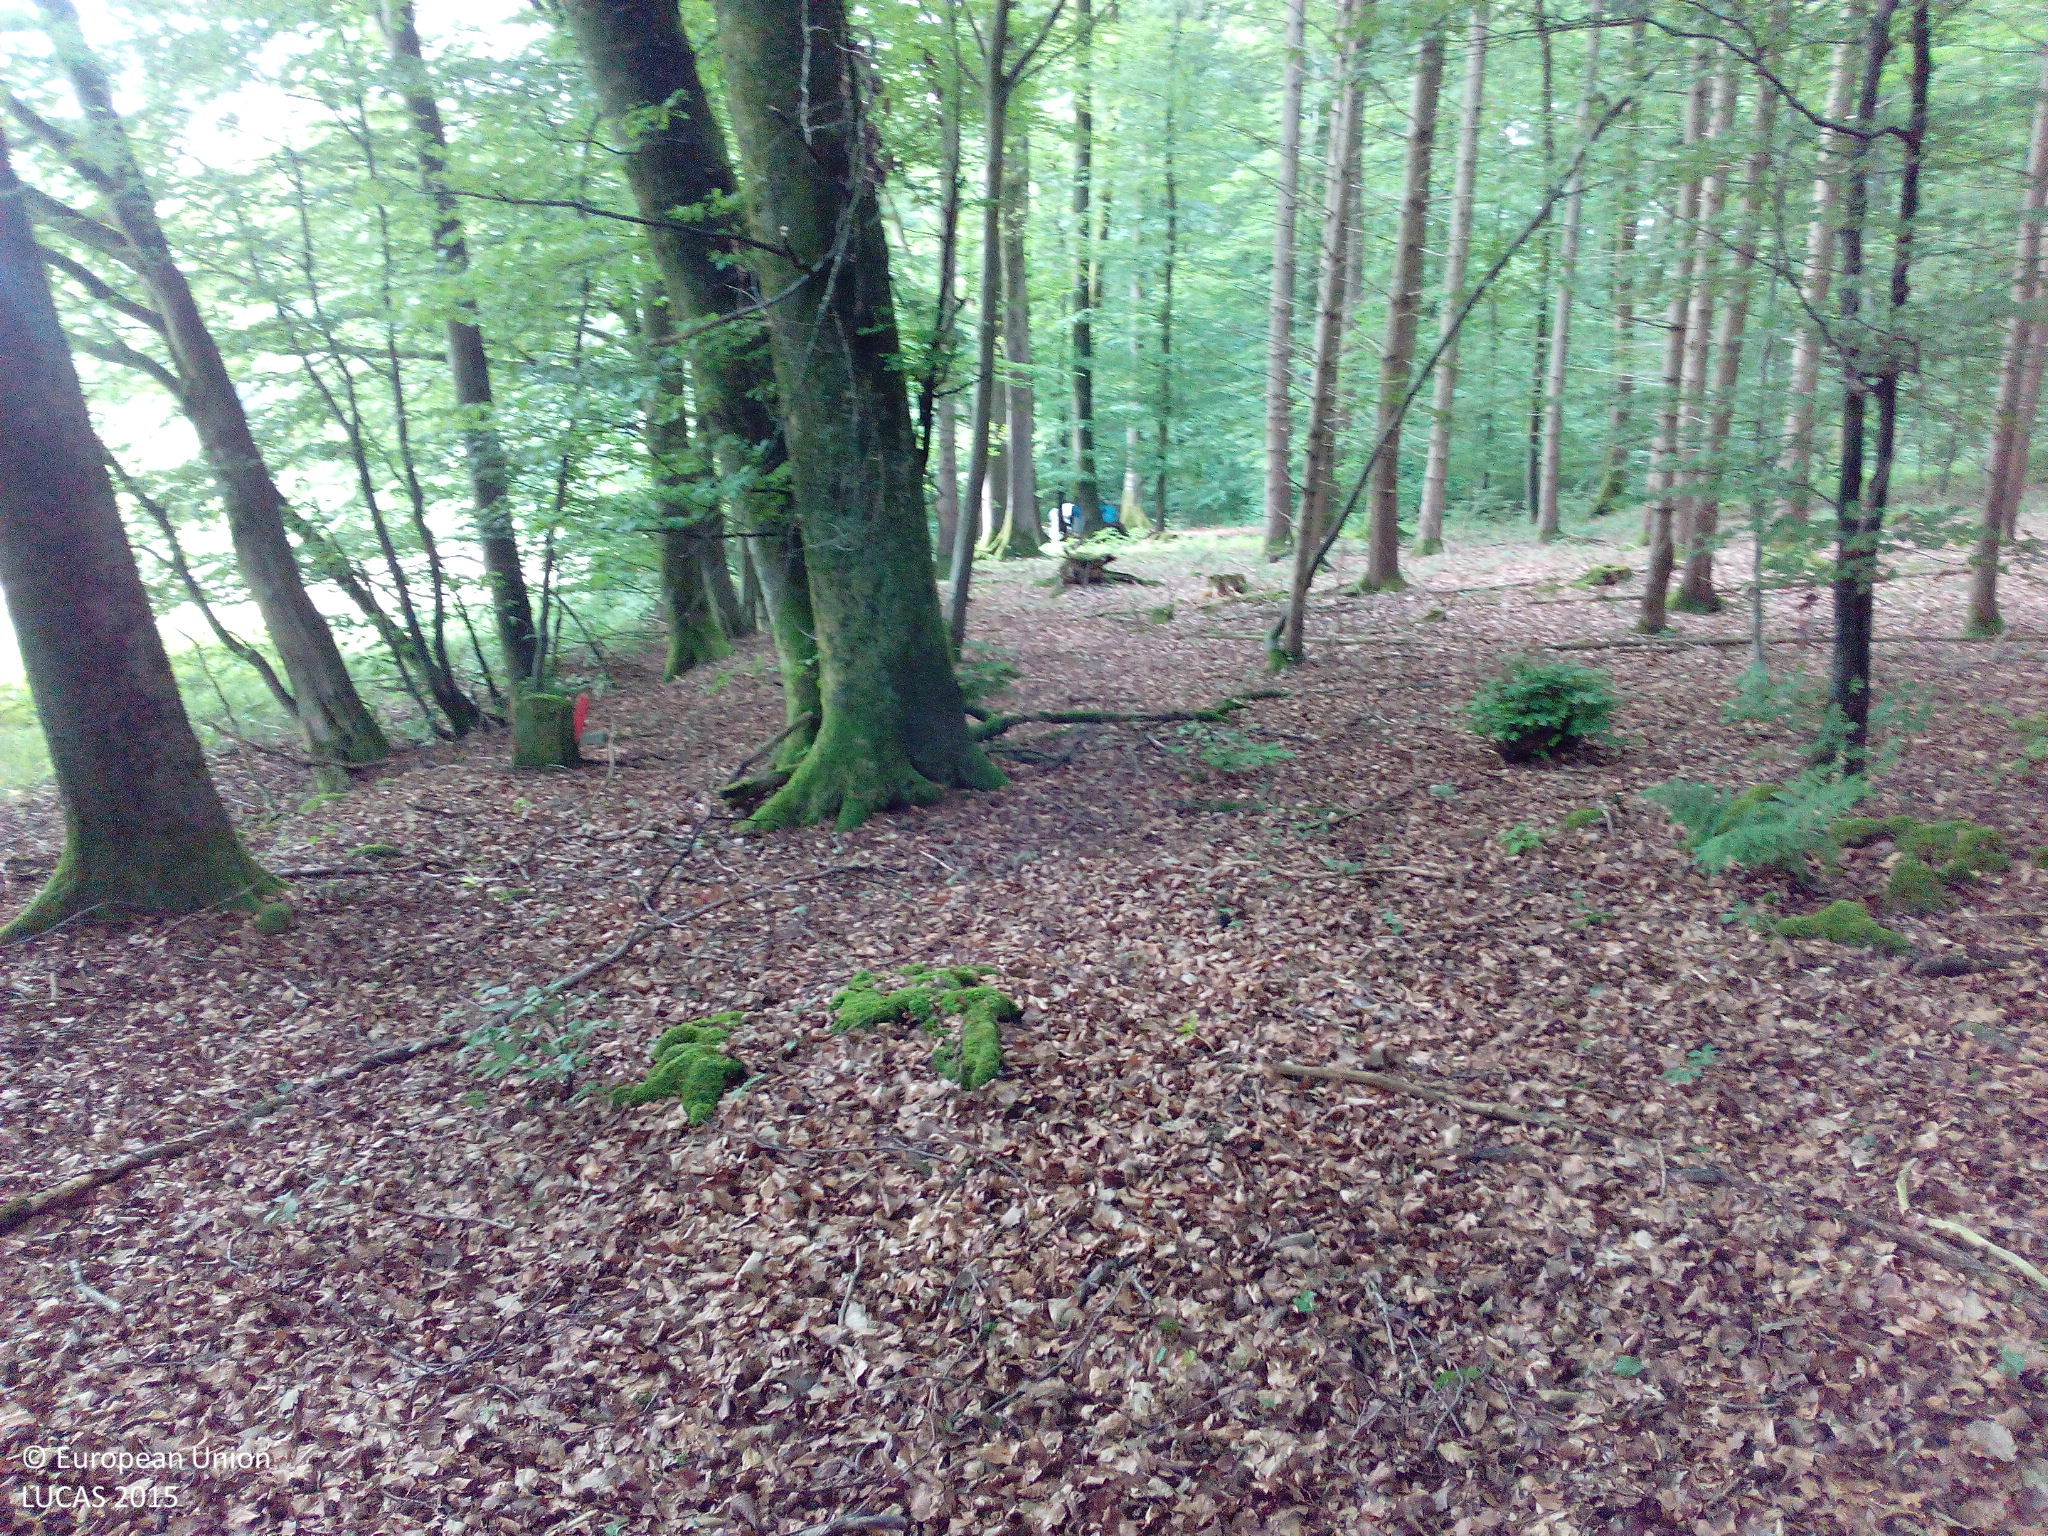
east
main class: Woodland
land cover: Broadleaved woodland
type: mesophytic deciduous forest
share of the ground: > 75 %
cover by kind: broadleaved forest trees 100 %
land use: Forestry
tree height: > 5 m
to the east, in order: Broadleaved woodland; Grassland without tree/shrub cover; Rivers and streams; Broadleaved woodland; Ditches and canals; Broadleaved woodland
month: June
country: DE
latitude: 48.7269
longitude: 9.6875
